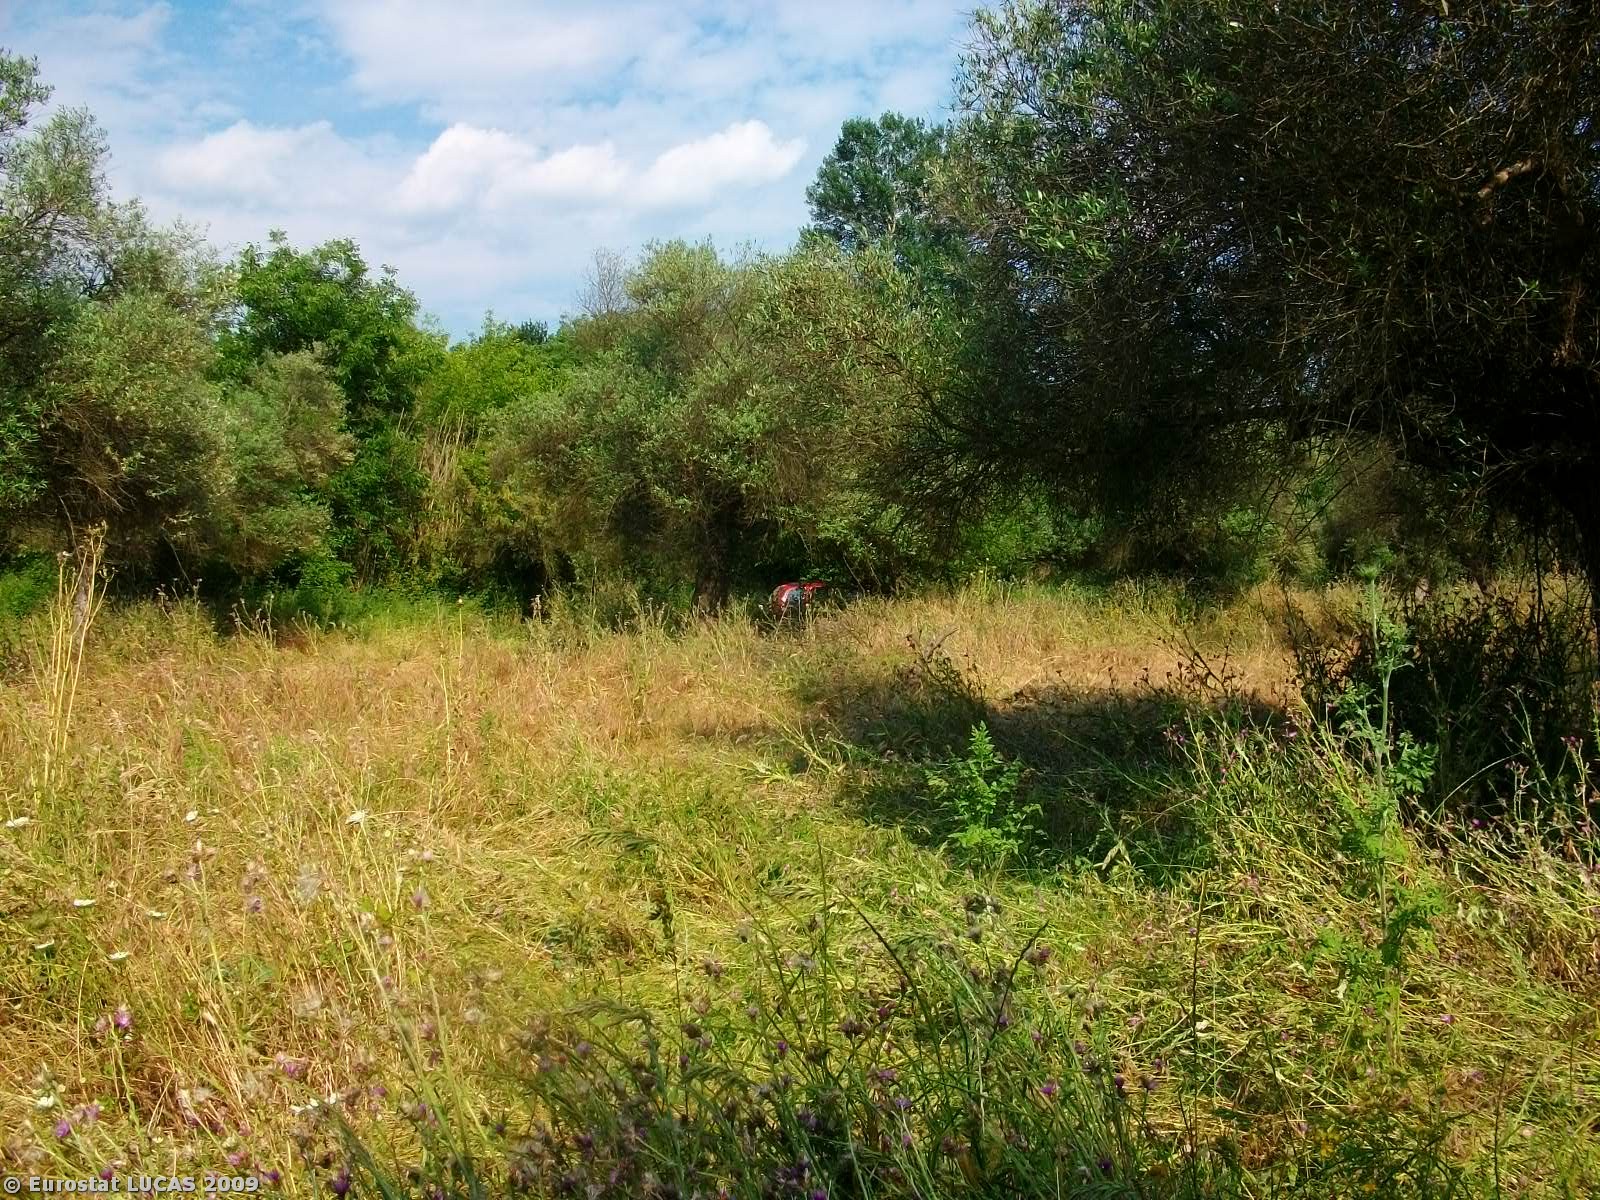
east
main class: Cropland
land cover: Olive groves
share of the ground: 25 - 50 %
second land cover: Grassland with sparse tree/shrub cover
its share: > 75 %
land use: Fallow land
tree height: < 5 m
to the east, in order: Olive groves; Grassland with sparse tree/shrub cover; Tracks; Shruby margins; Inland running water; Shruby margins; Mixed woodland; Spontaneously vegetated surfaces
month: May
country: GR
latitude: 37.1556
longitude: 22.3766
